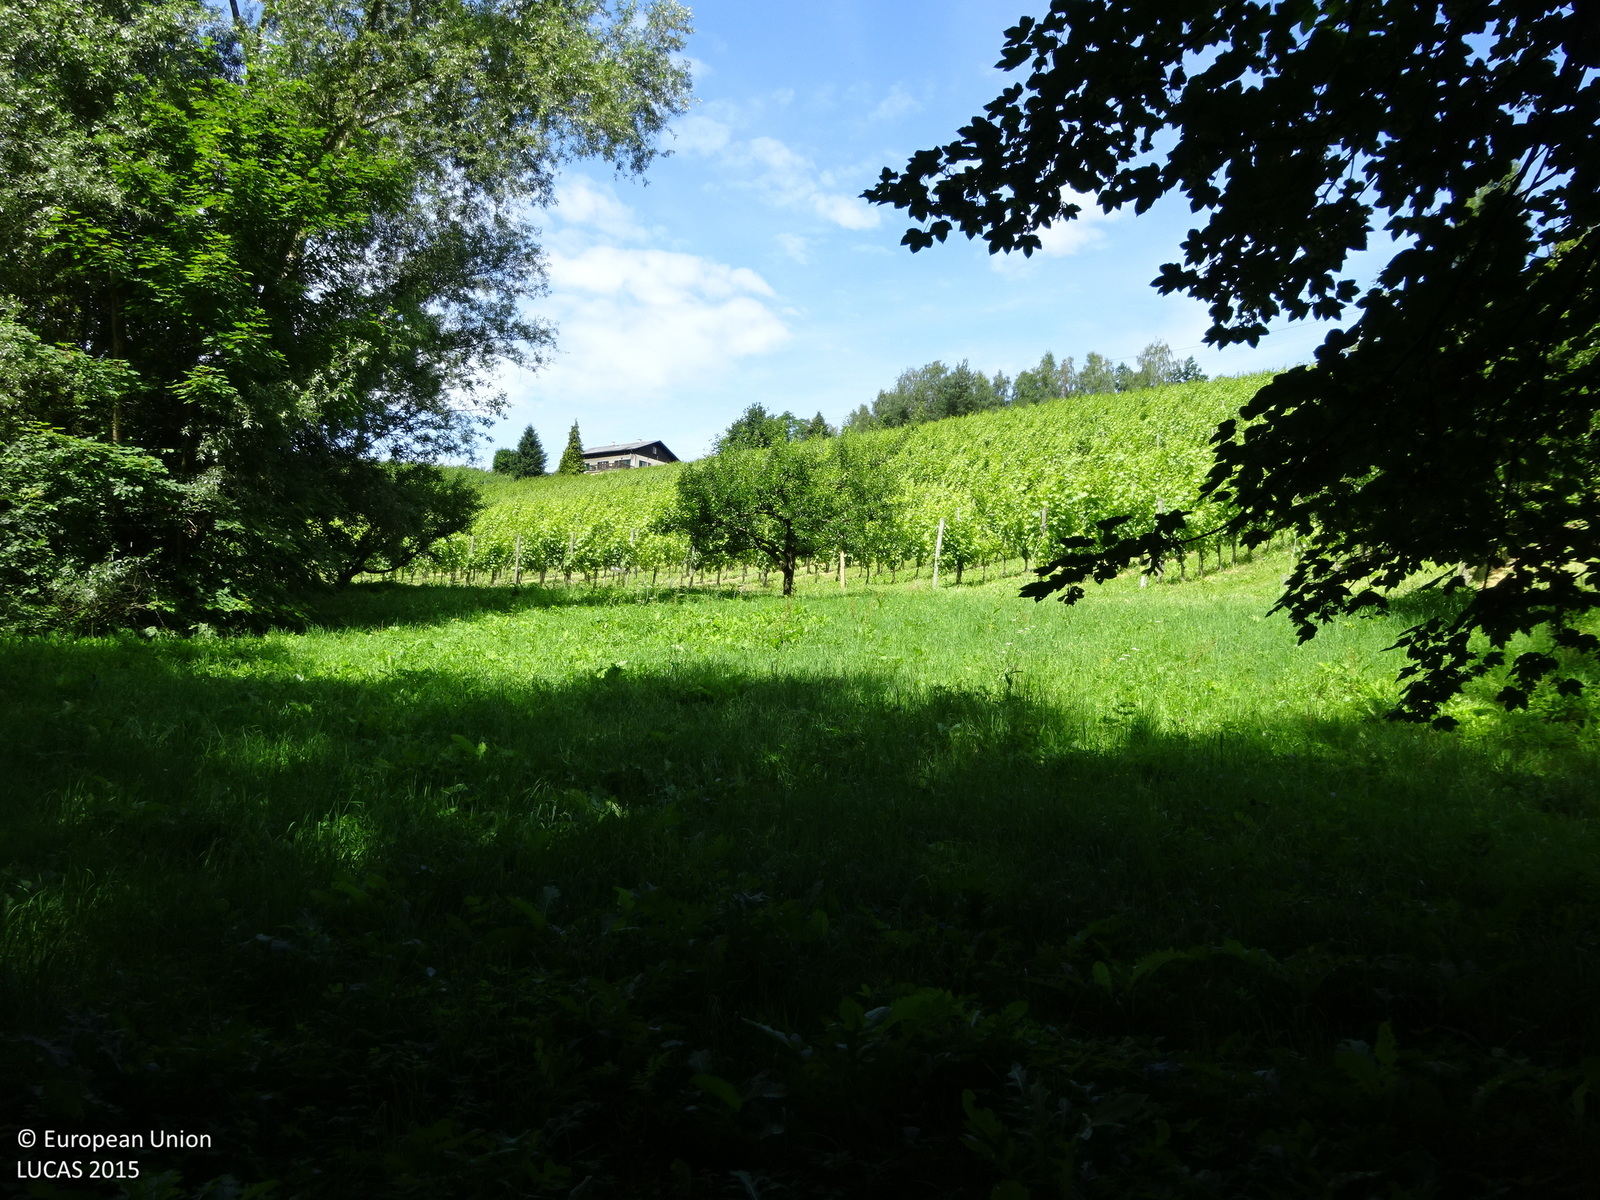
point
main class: Cropland
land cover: Vineyards
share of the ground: 50 - 75 %
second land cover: Grassland without tree/shrub cover
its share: 50 - 75 %
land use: Agriculture (excluding fallow land and kitchen gardens)
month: June
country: AT
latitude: 46.7121
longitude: 15.5588
